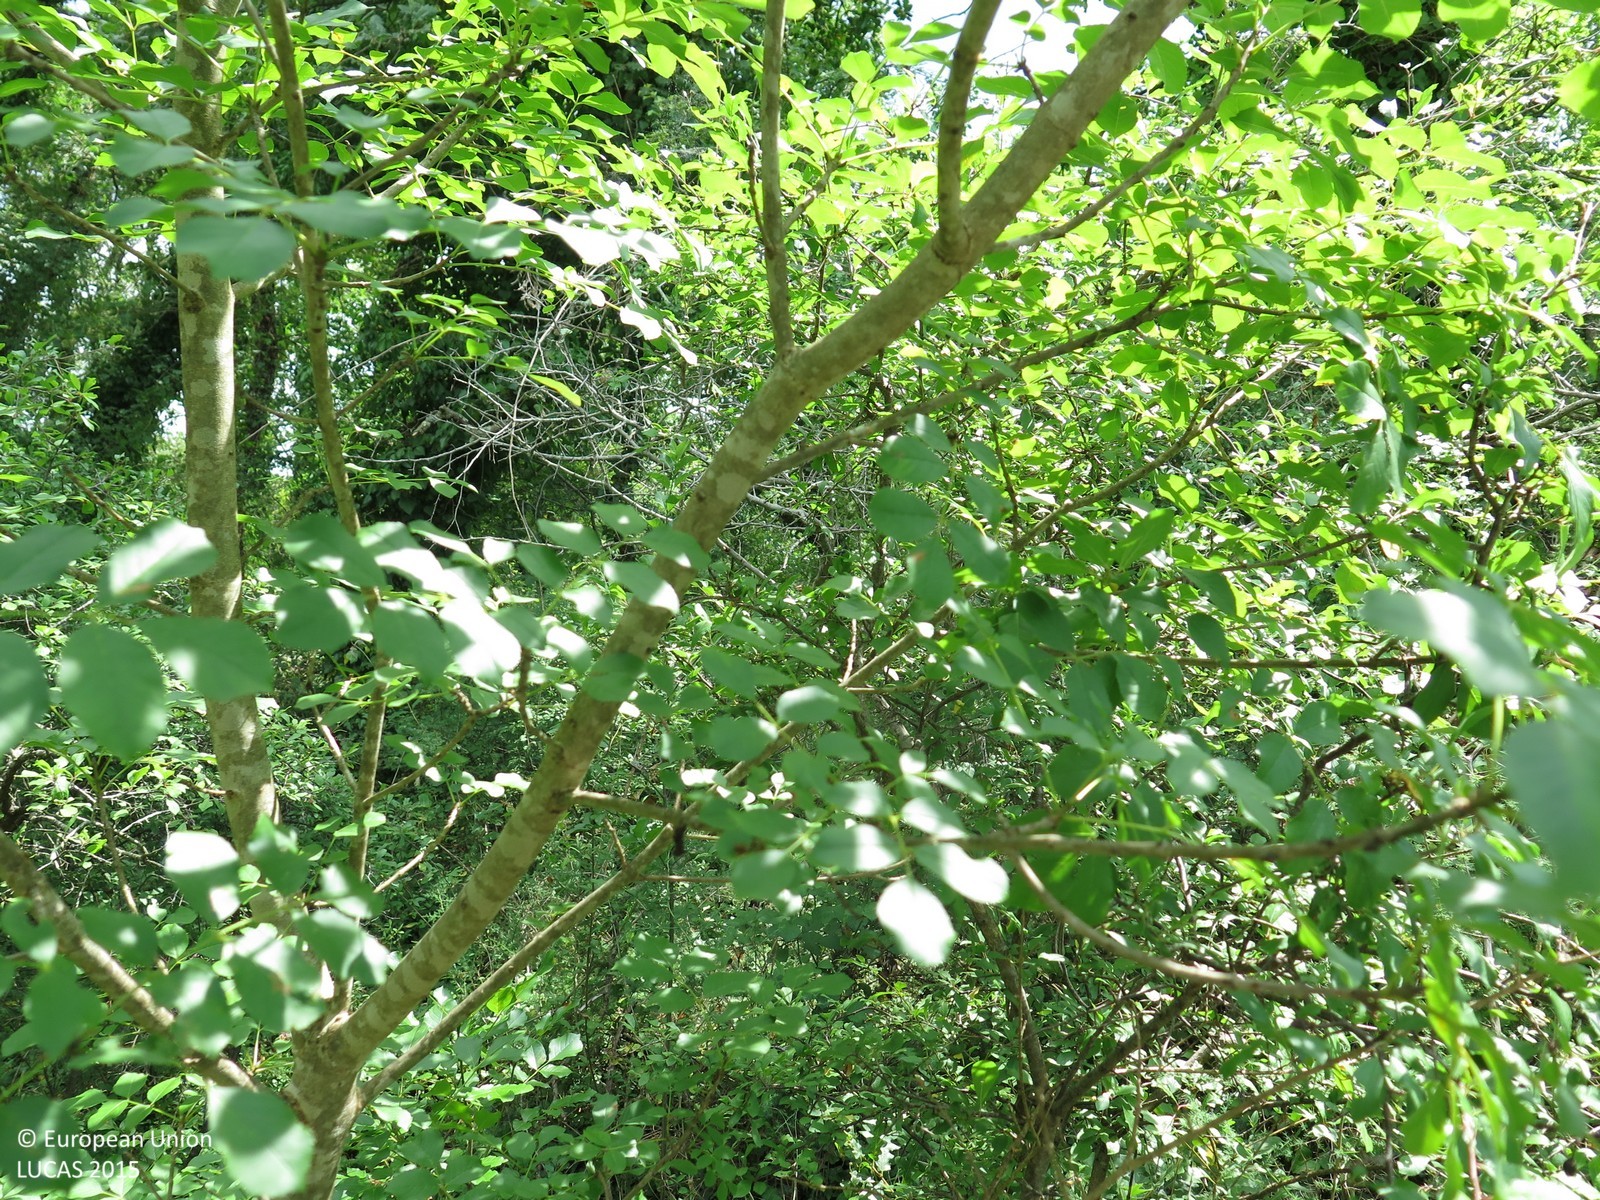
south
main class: Shrubland
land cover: Shrubland with sparse tree cover
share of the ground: > 75 %
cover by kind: shrubs 90 %, broadleaved forest trees 5 %, herbaceous plants 5 %
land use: Semi-natural and natural areas not in use
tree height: > 5 m
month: June
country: HR
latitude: 45.2753
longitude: 13.7553
